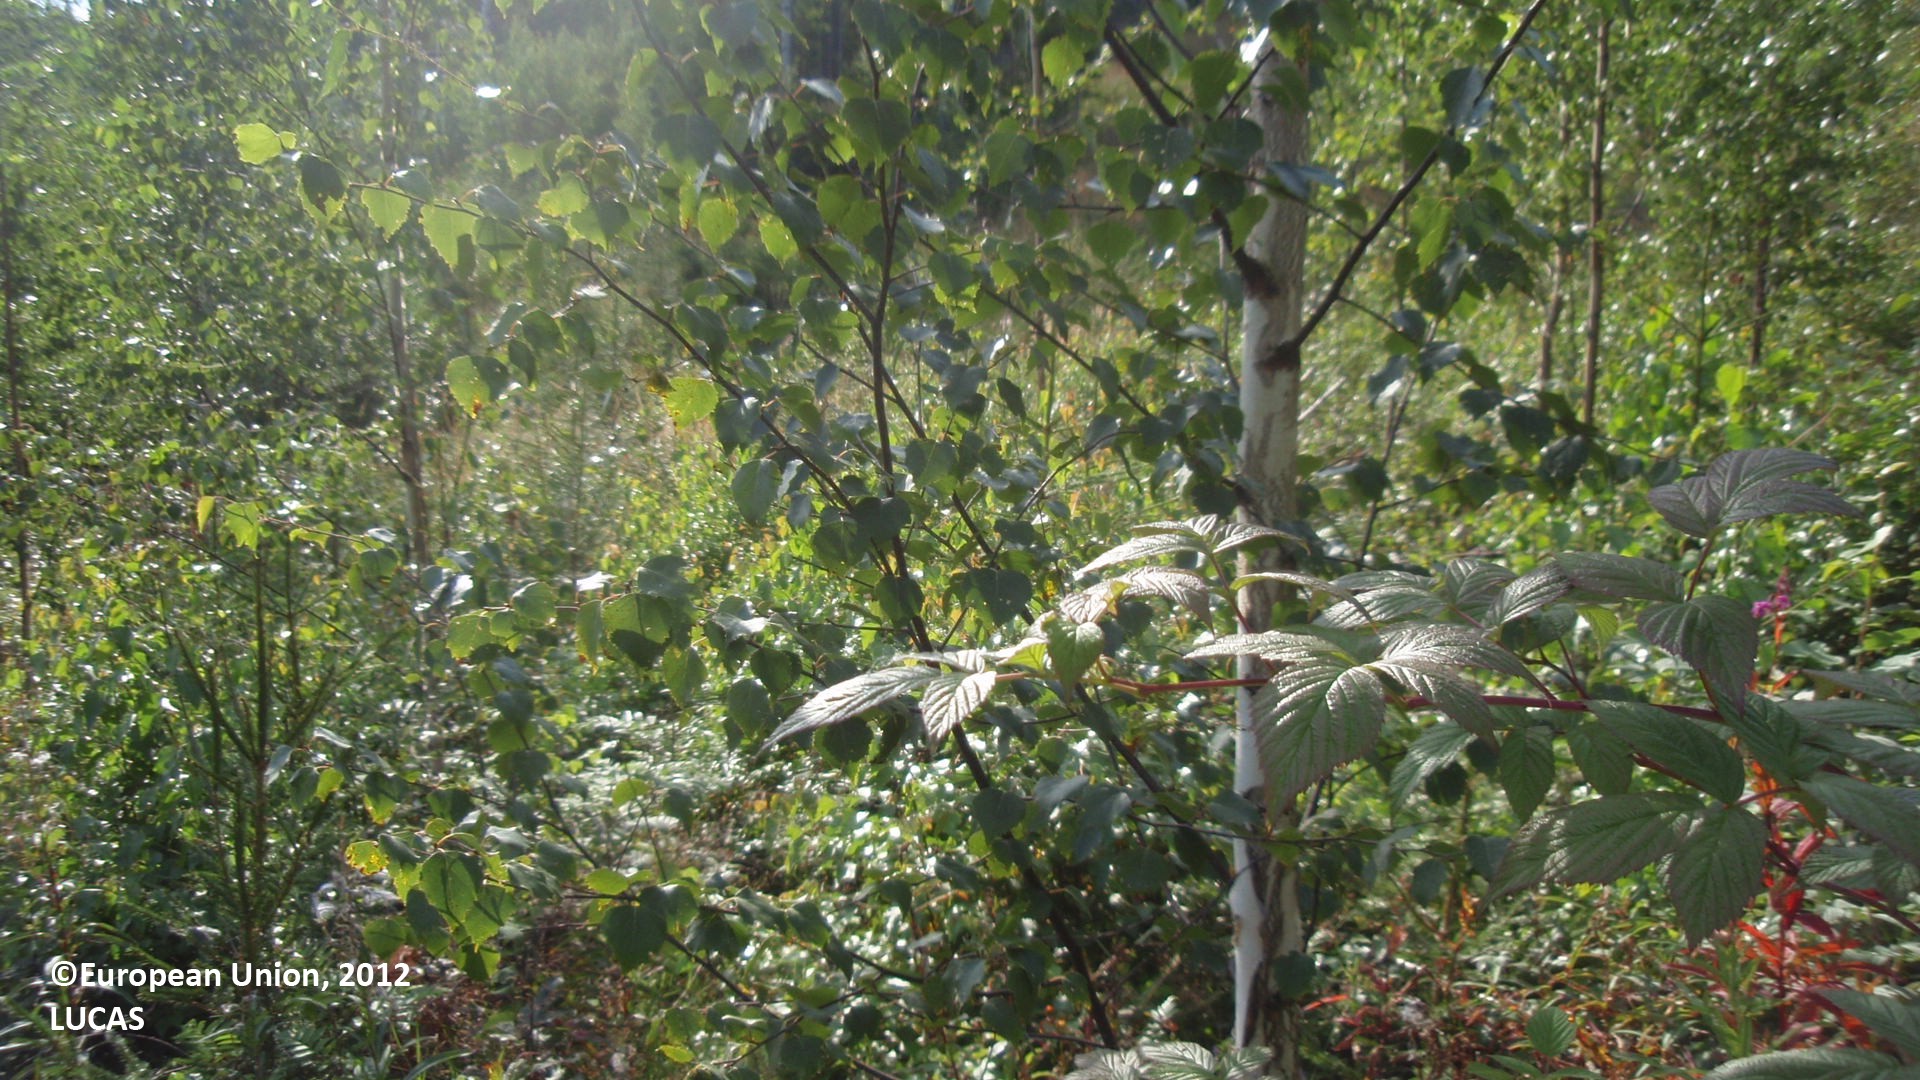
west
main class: Shrubland
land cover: Shrubland with sparse tree cover
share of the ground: > 75 %
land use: Forestry
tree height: < 5 m
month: August
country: FI
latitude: 61.5539
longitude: 27.6656
